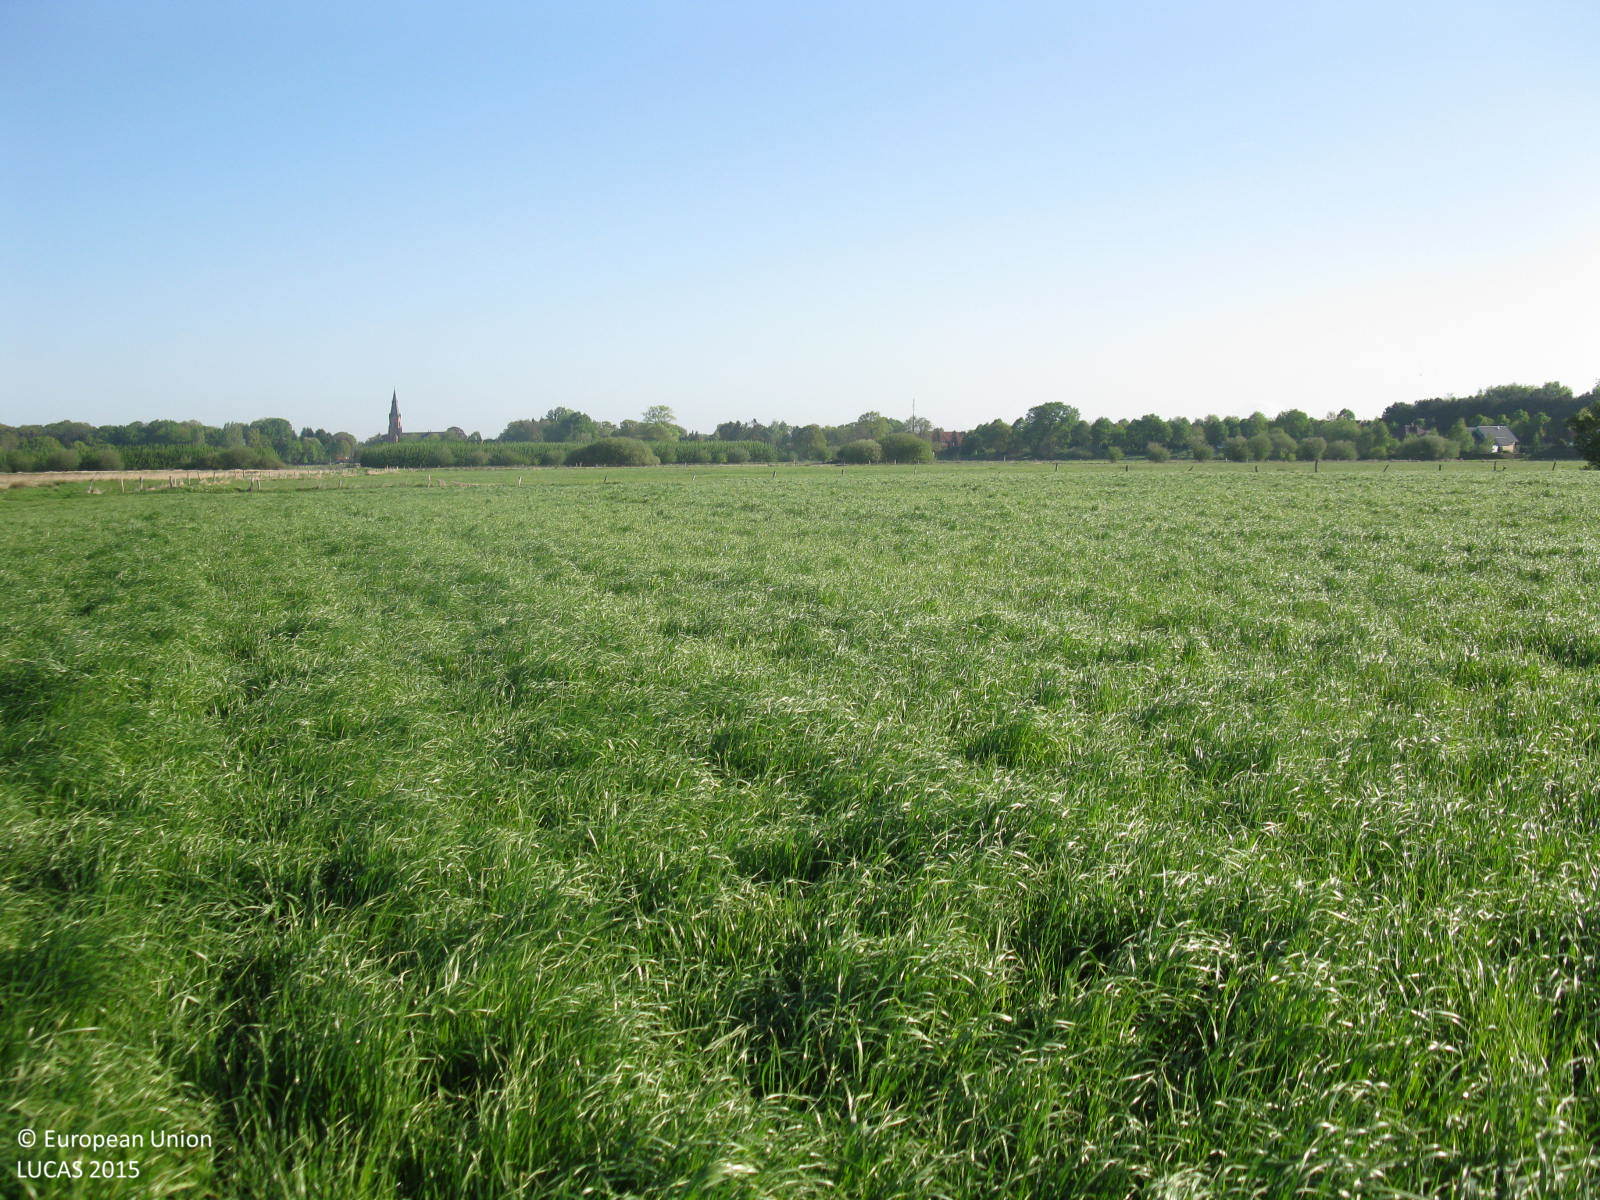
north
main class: Grassland
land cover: Grassland without tree/shrub cover
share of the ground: > 75 %
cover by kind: herbaceous plants 100 %
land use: Agriculture (excluding fallow land and kitchen gardens)
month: May
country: DE
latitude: 52.8506
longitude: 7.3127
